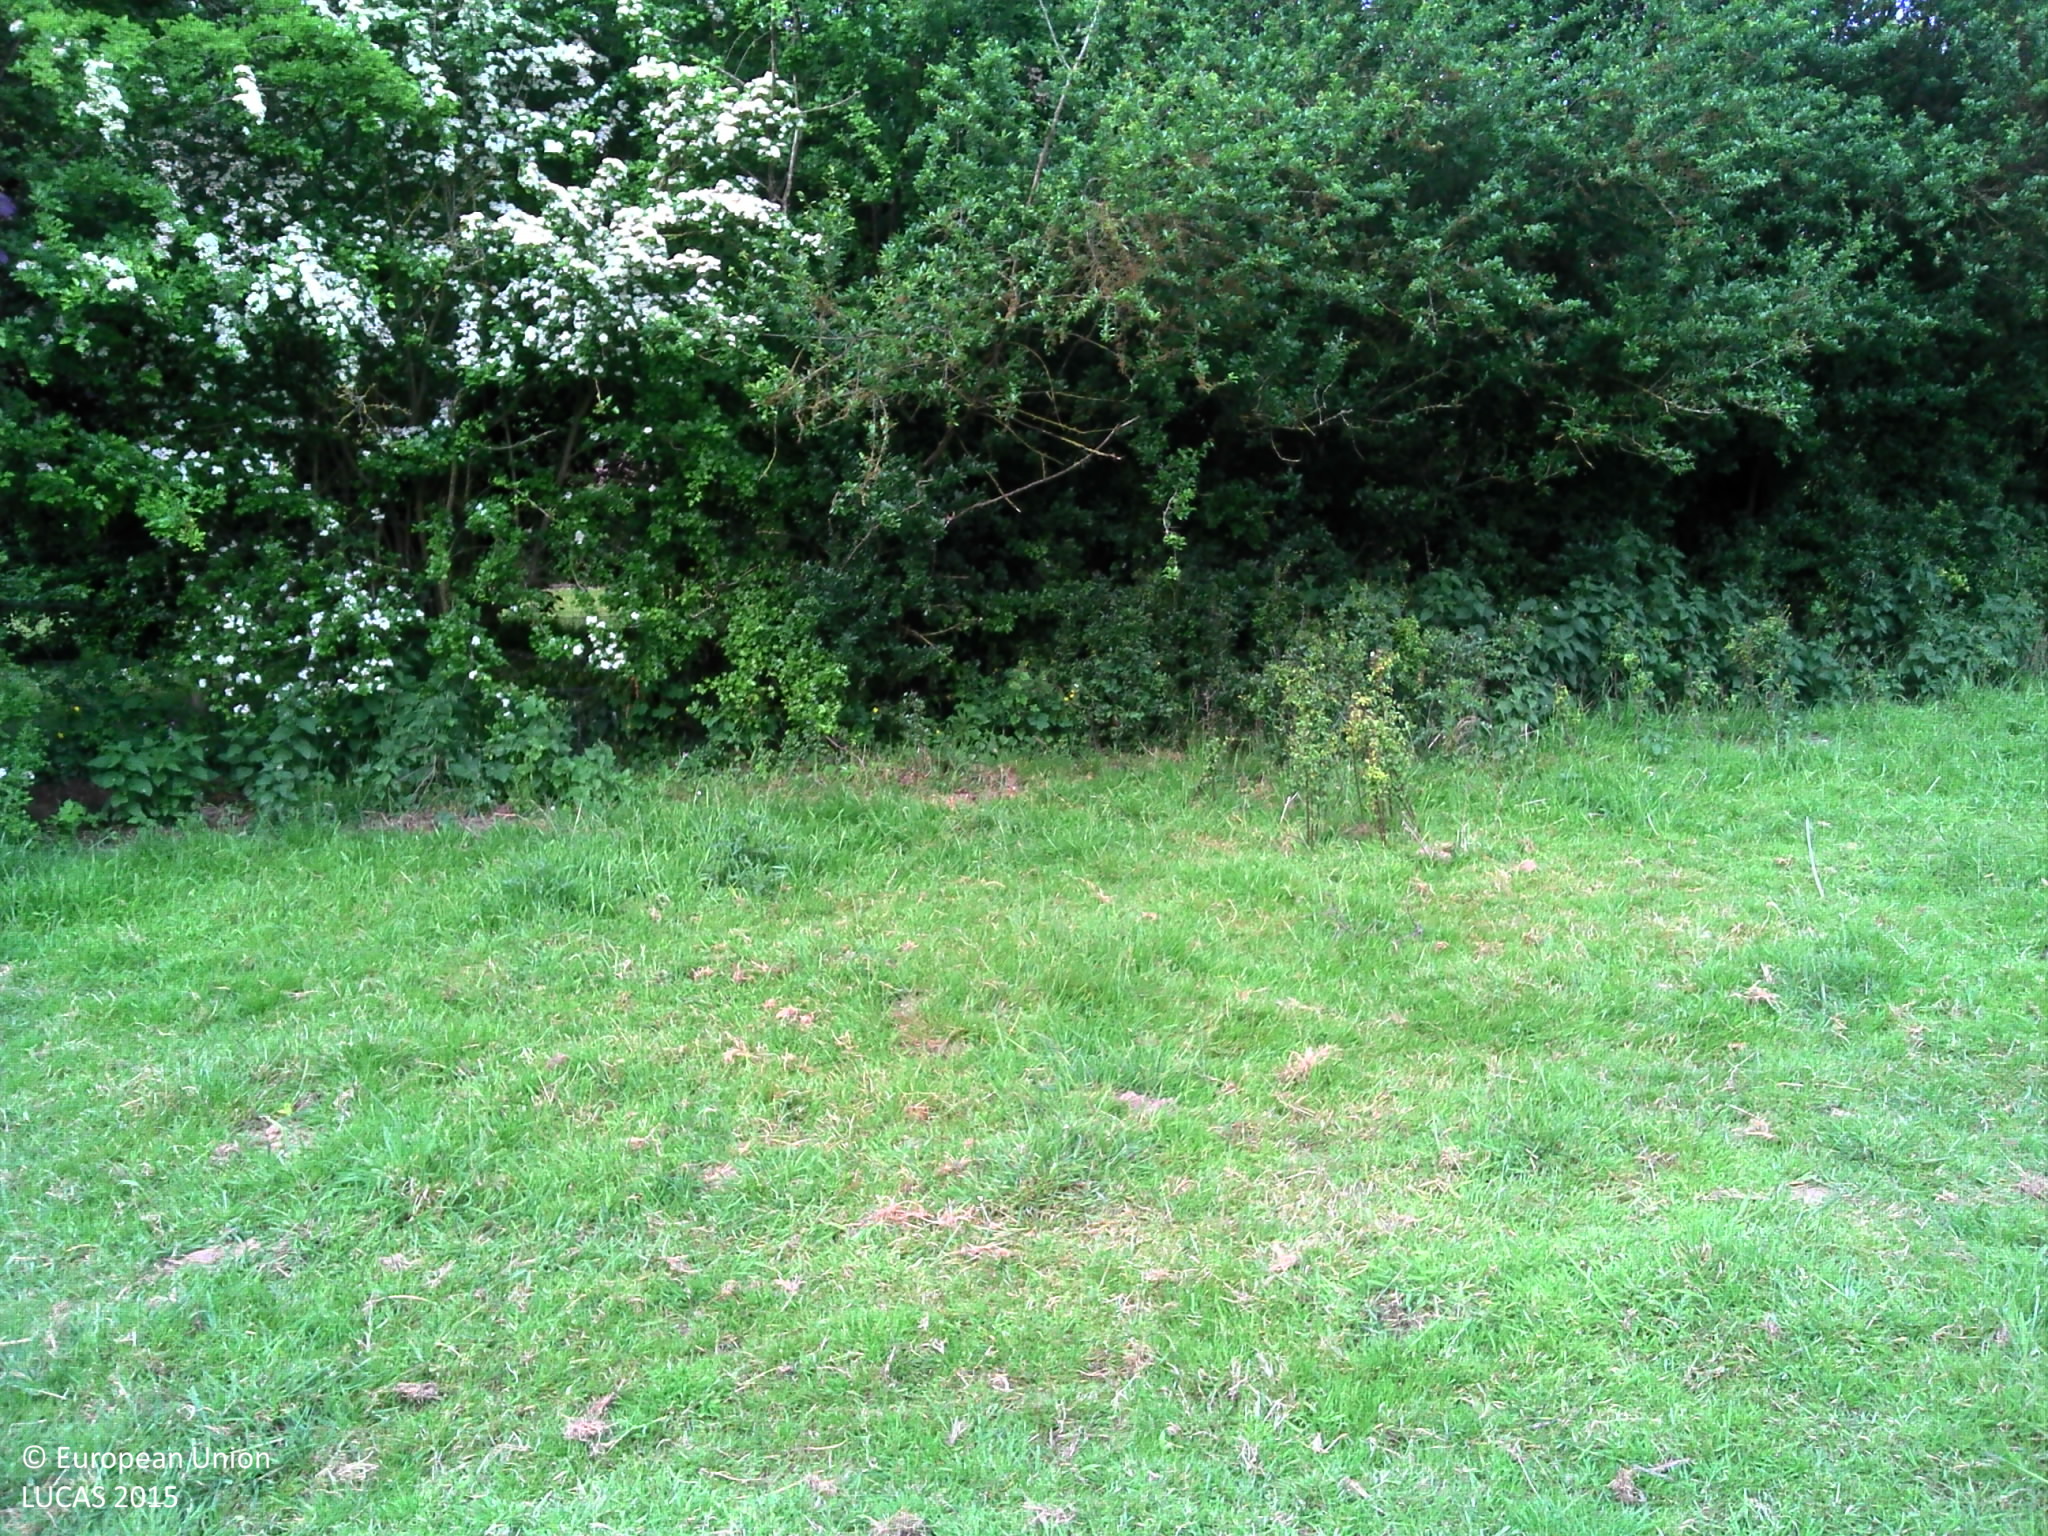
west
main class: Grassland
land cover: Grassland without tree/shrub cover
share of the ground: > 75 %
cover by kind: herbaceous plants 100 %
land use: Agriculture (excluding fallow land and kitchen gardens)
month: May
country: FR
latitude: 50.5949
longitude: 2.3438
